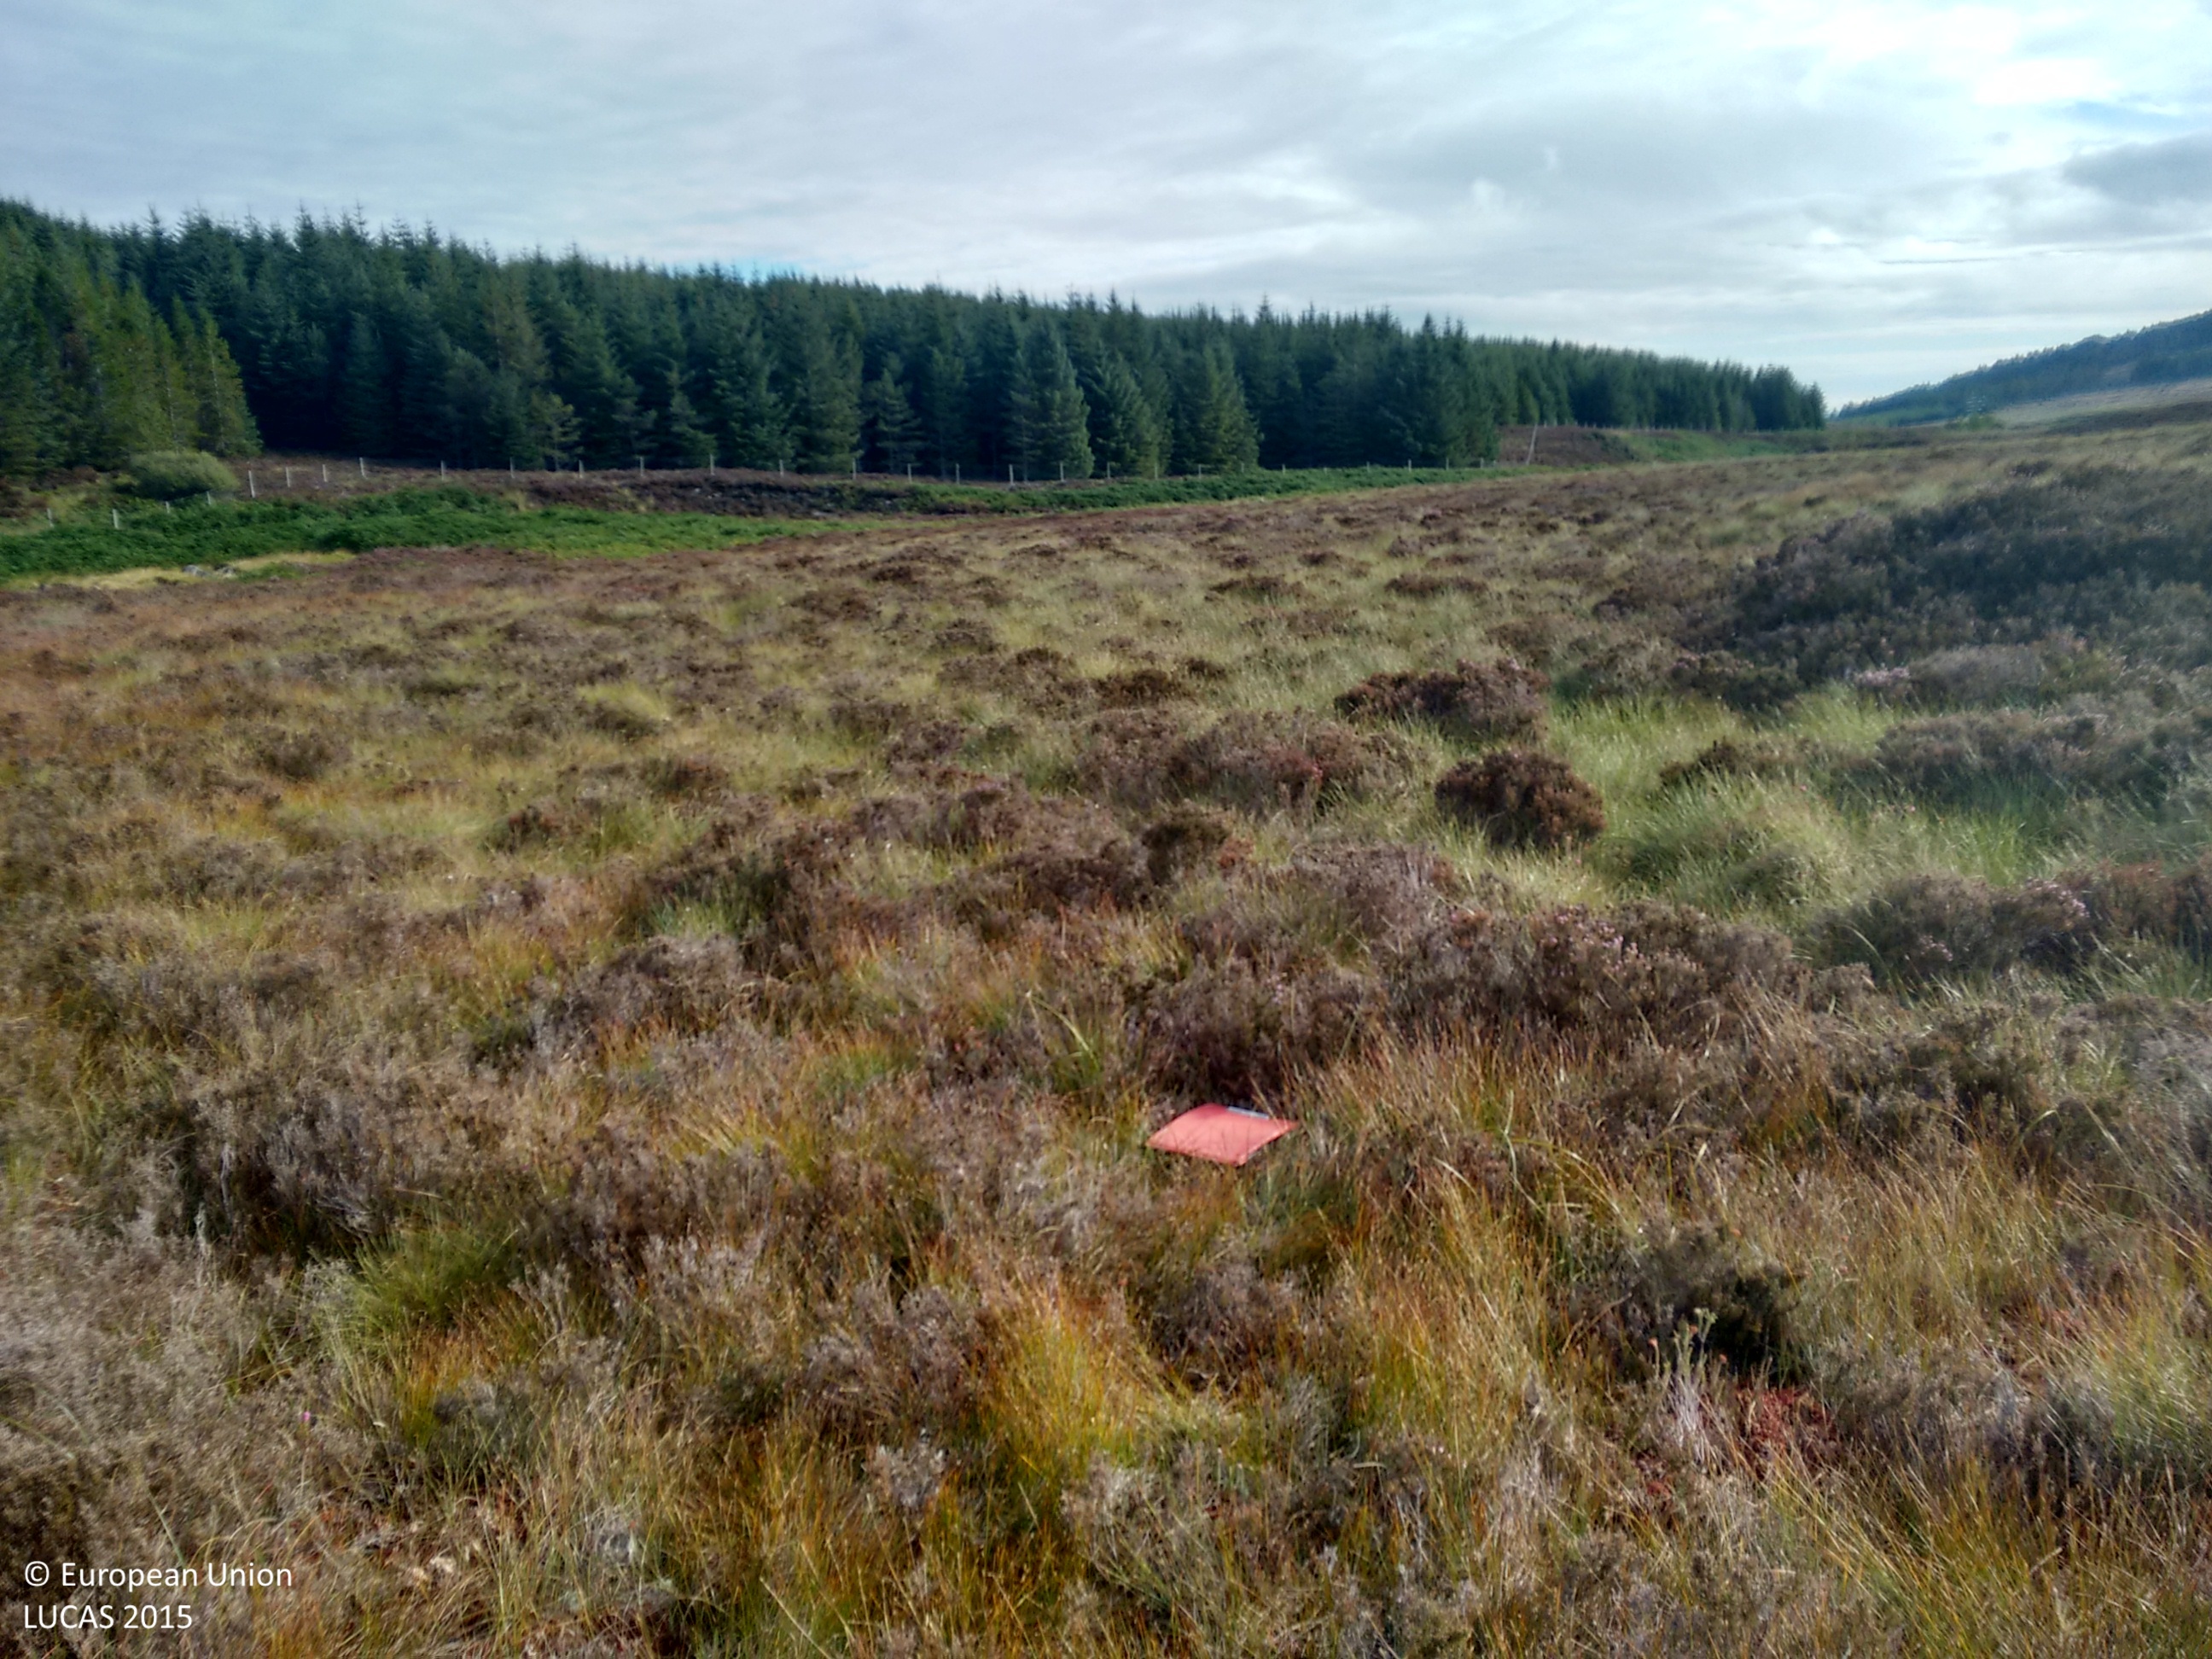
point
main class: Shrubland
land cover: Shrubland without tree cover
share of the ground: > 75 %
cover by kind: shrubs 75 %, herbaceous plants 20 %, lichens and mosses 5 %
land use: Semi-natural and natural areas not in use
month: September
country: GB
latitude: 57.8461
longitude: -4.3553
